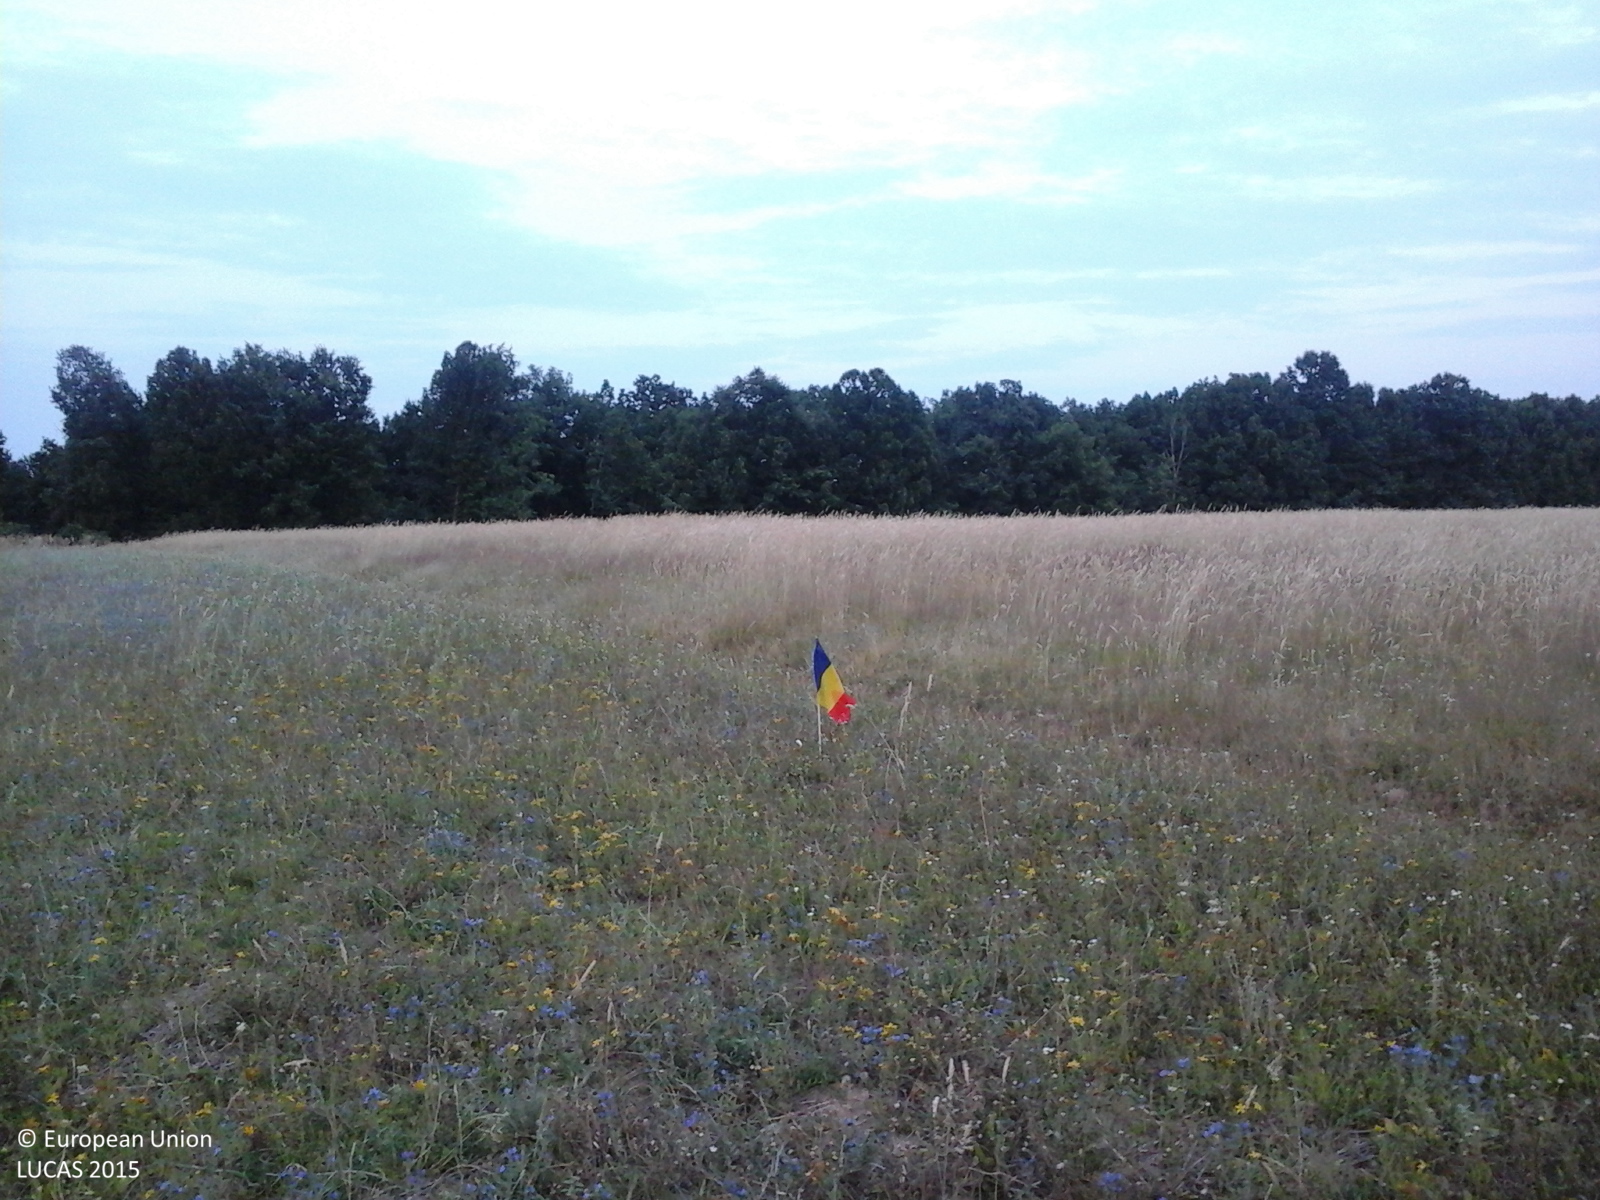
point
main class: Grassland
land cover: Grassland without tree/shrub cover
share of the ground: > 75 %
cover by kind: herbaceous plants 100 %
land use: Agriculture (excluding fallow land and kitchen gardens)
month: July
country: RO
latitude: 44.9103
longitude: 24.5531
